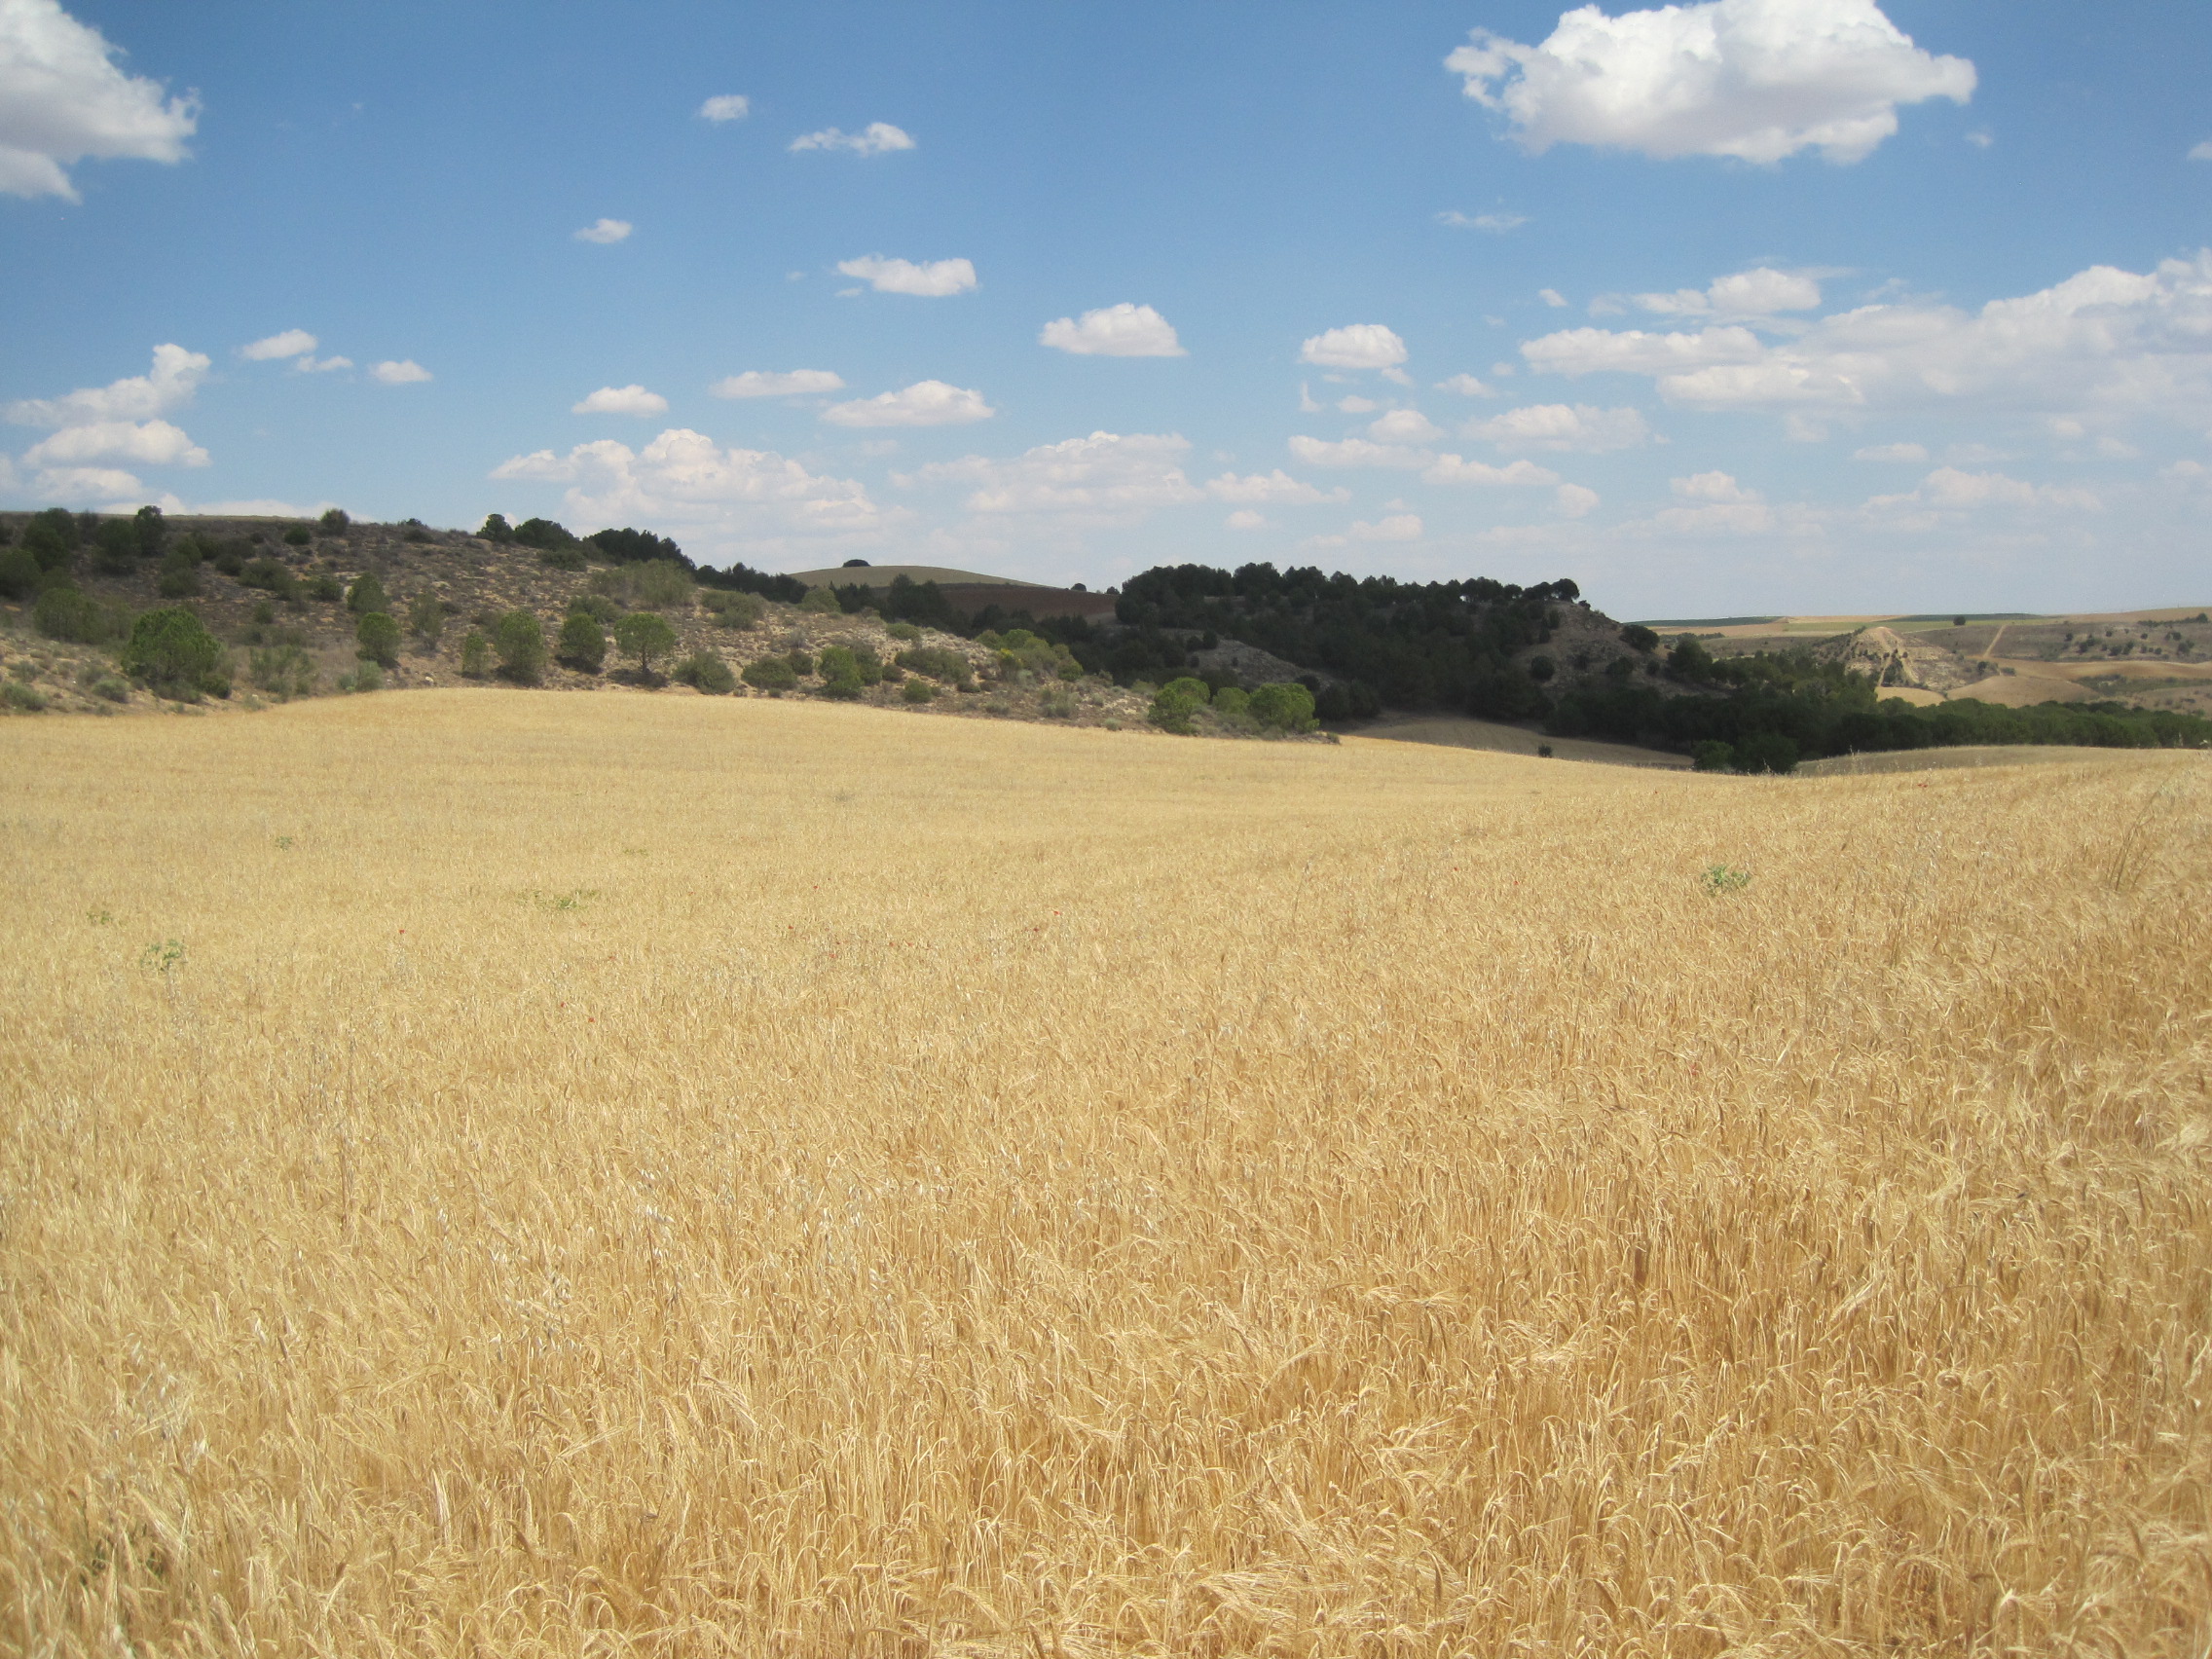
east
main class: Cropland
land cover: Barley
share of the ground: > 75 %
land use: Agriculture (excluding fallow land and kitchen gardens)
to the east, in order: Barley; Pine dominated coniferous woodland; Barley
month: June
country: ES
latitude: 41.3601
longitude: -5.2684
